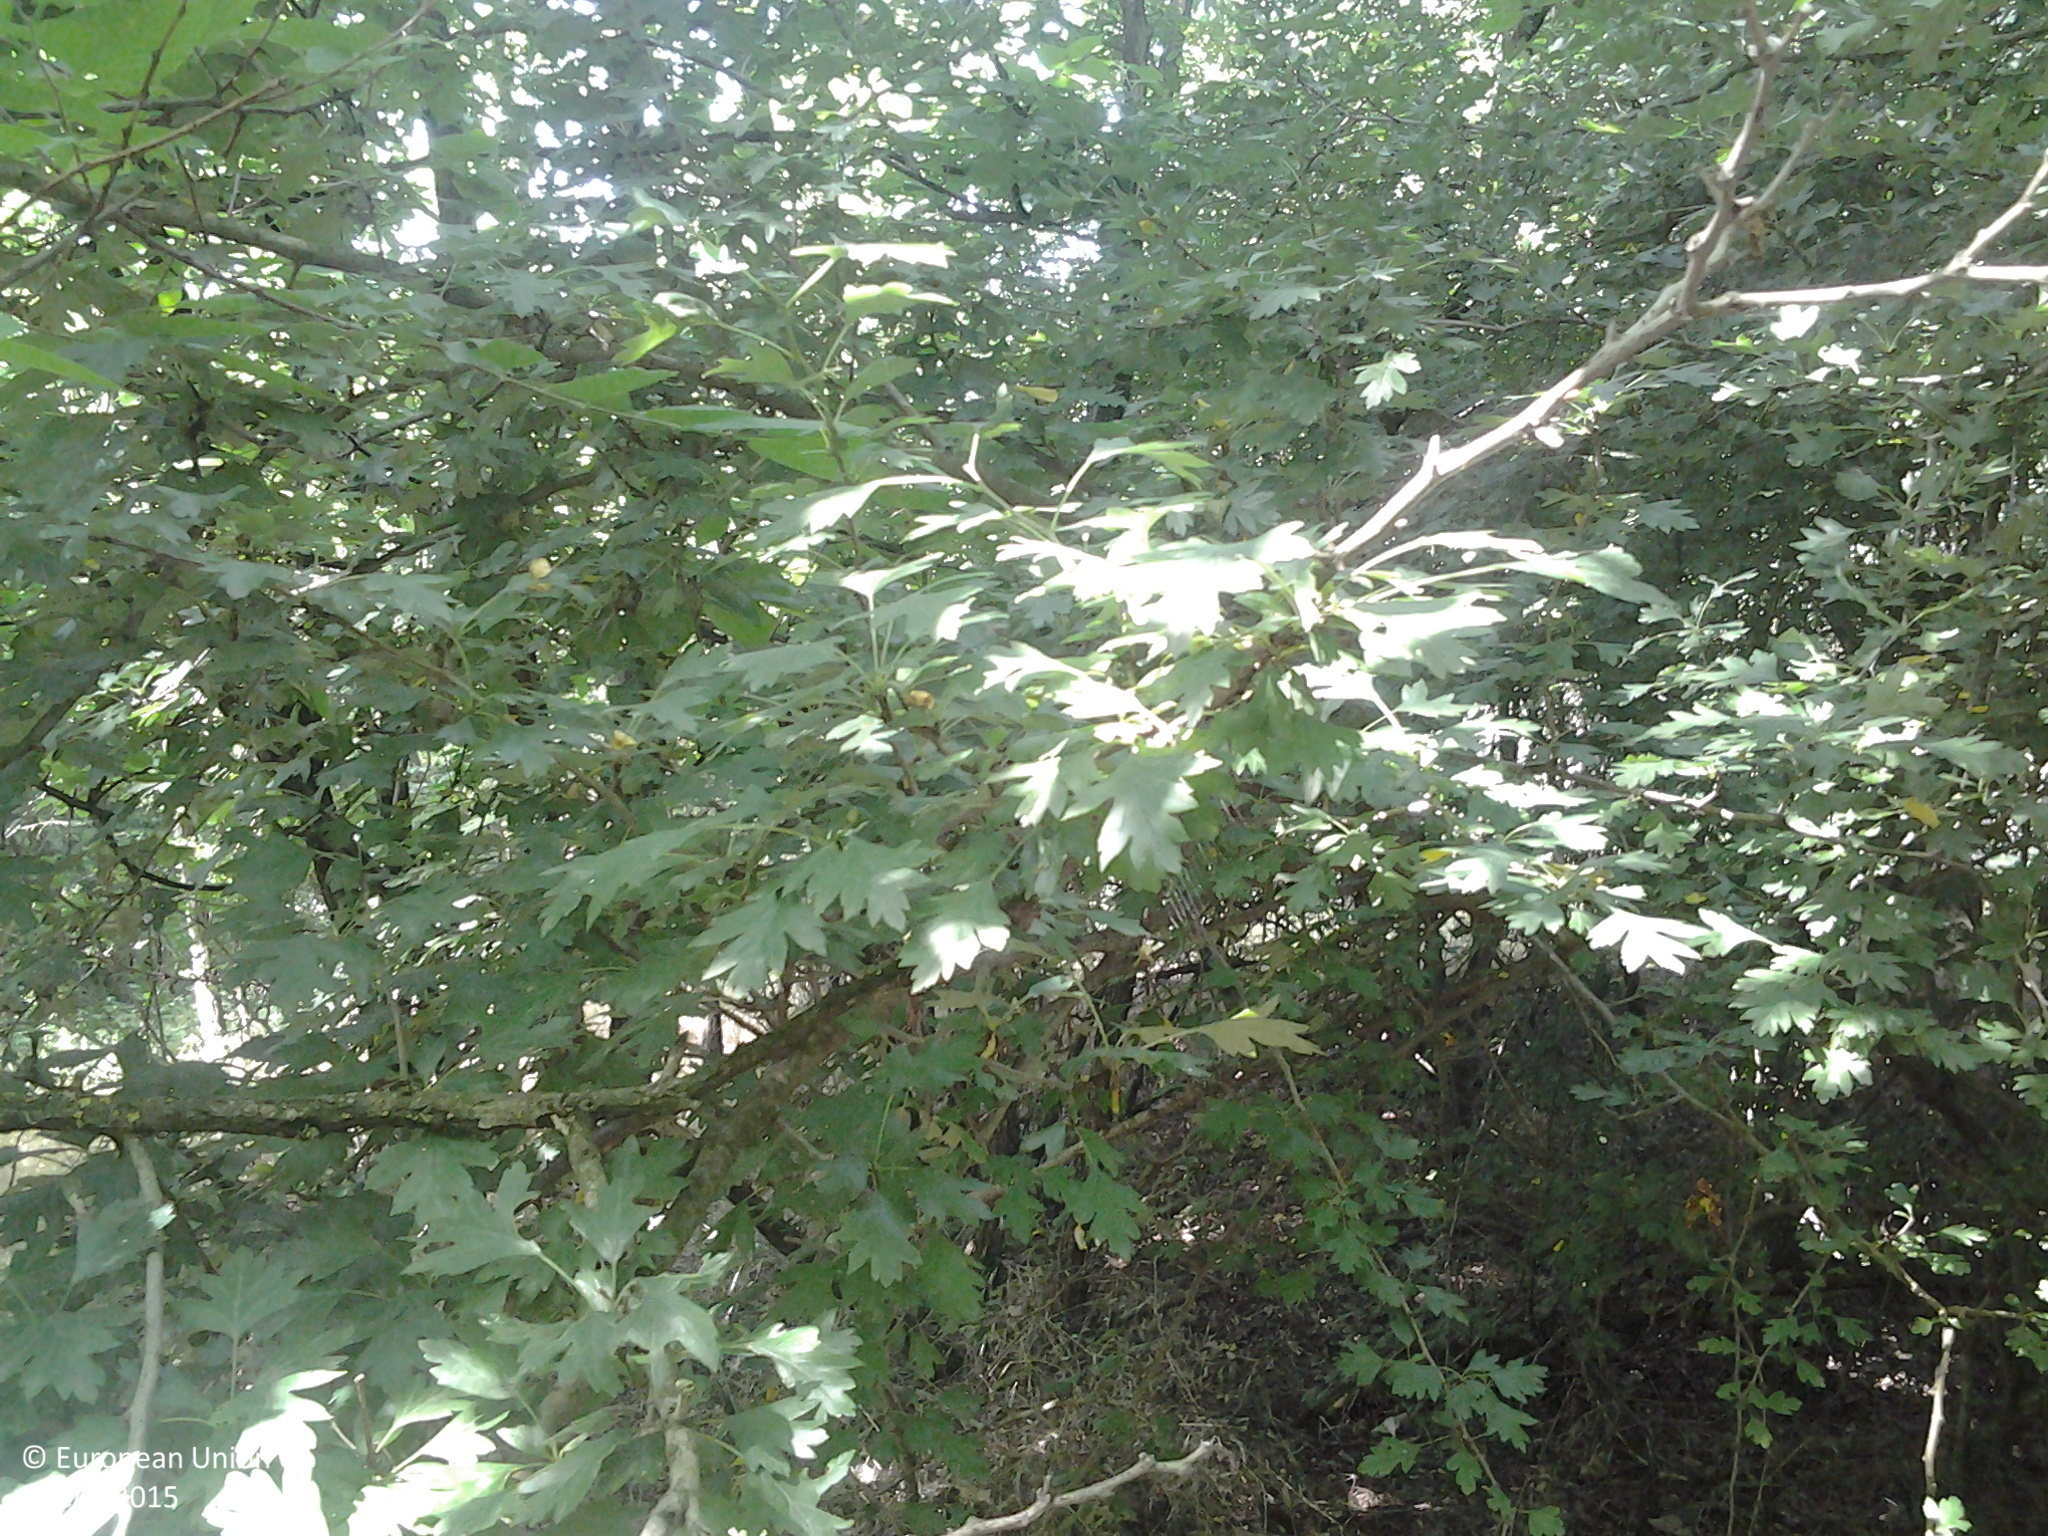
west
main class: Woodland
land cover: Broadleaved woodland
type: mesophytic deciduous forest
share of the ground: > 75 %
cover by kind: broadleaved forest trees 95 %, shrubs 5 %
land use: Forestry
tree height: > 5 m
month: June
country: HU
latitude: 46.8047
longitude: 19.6246
